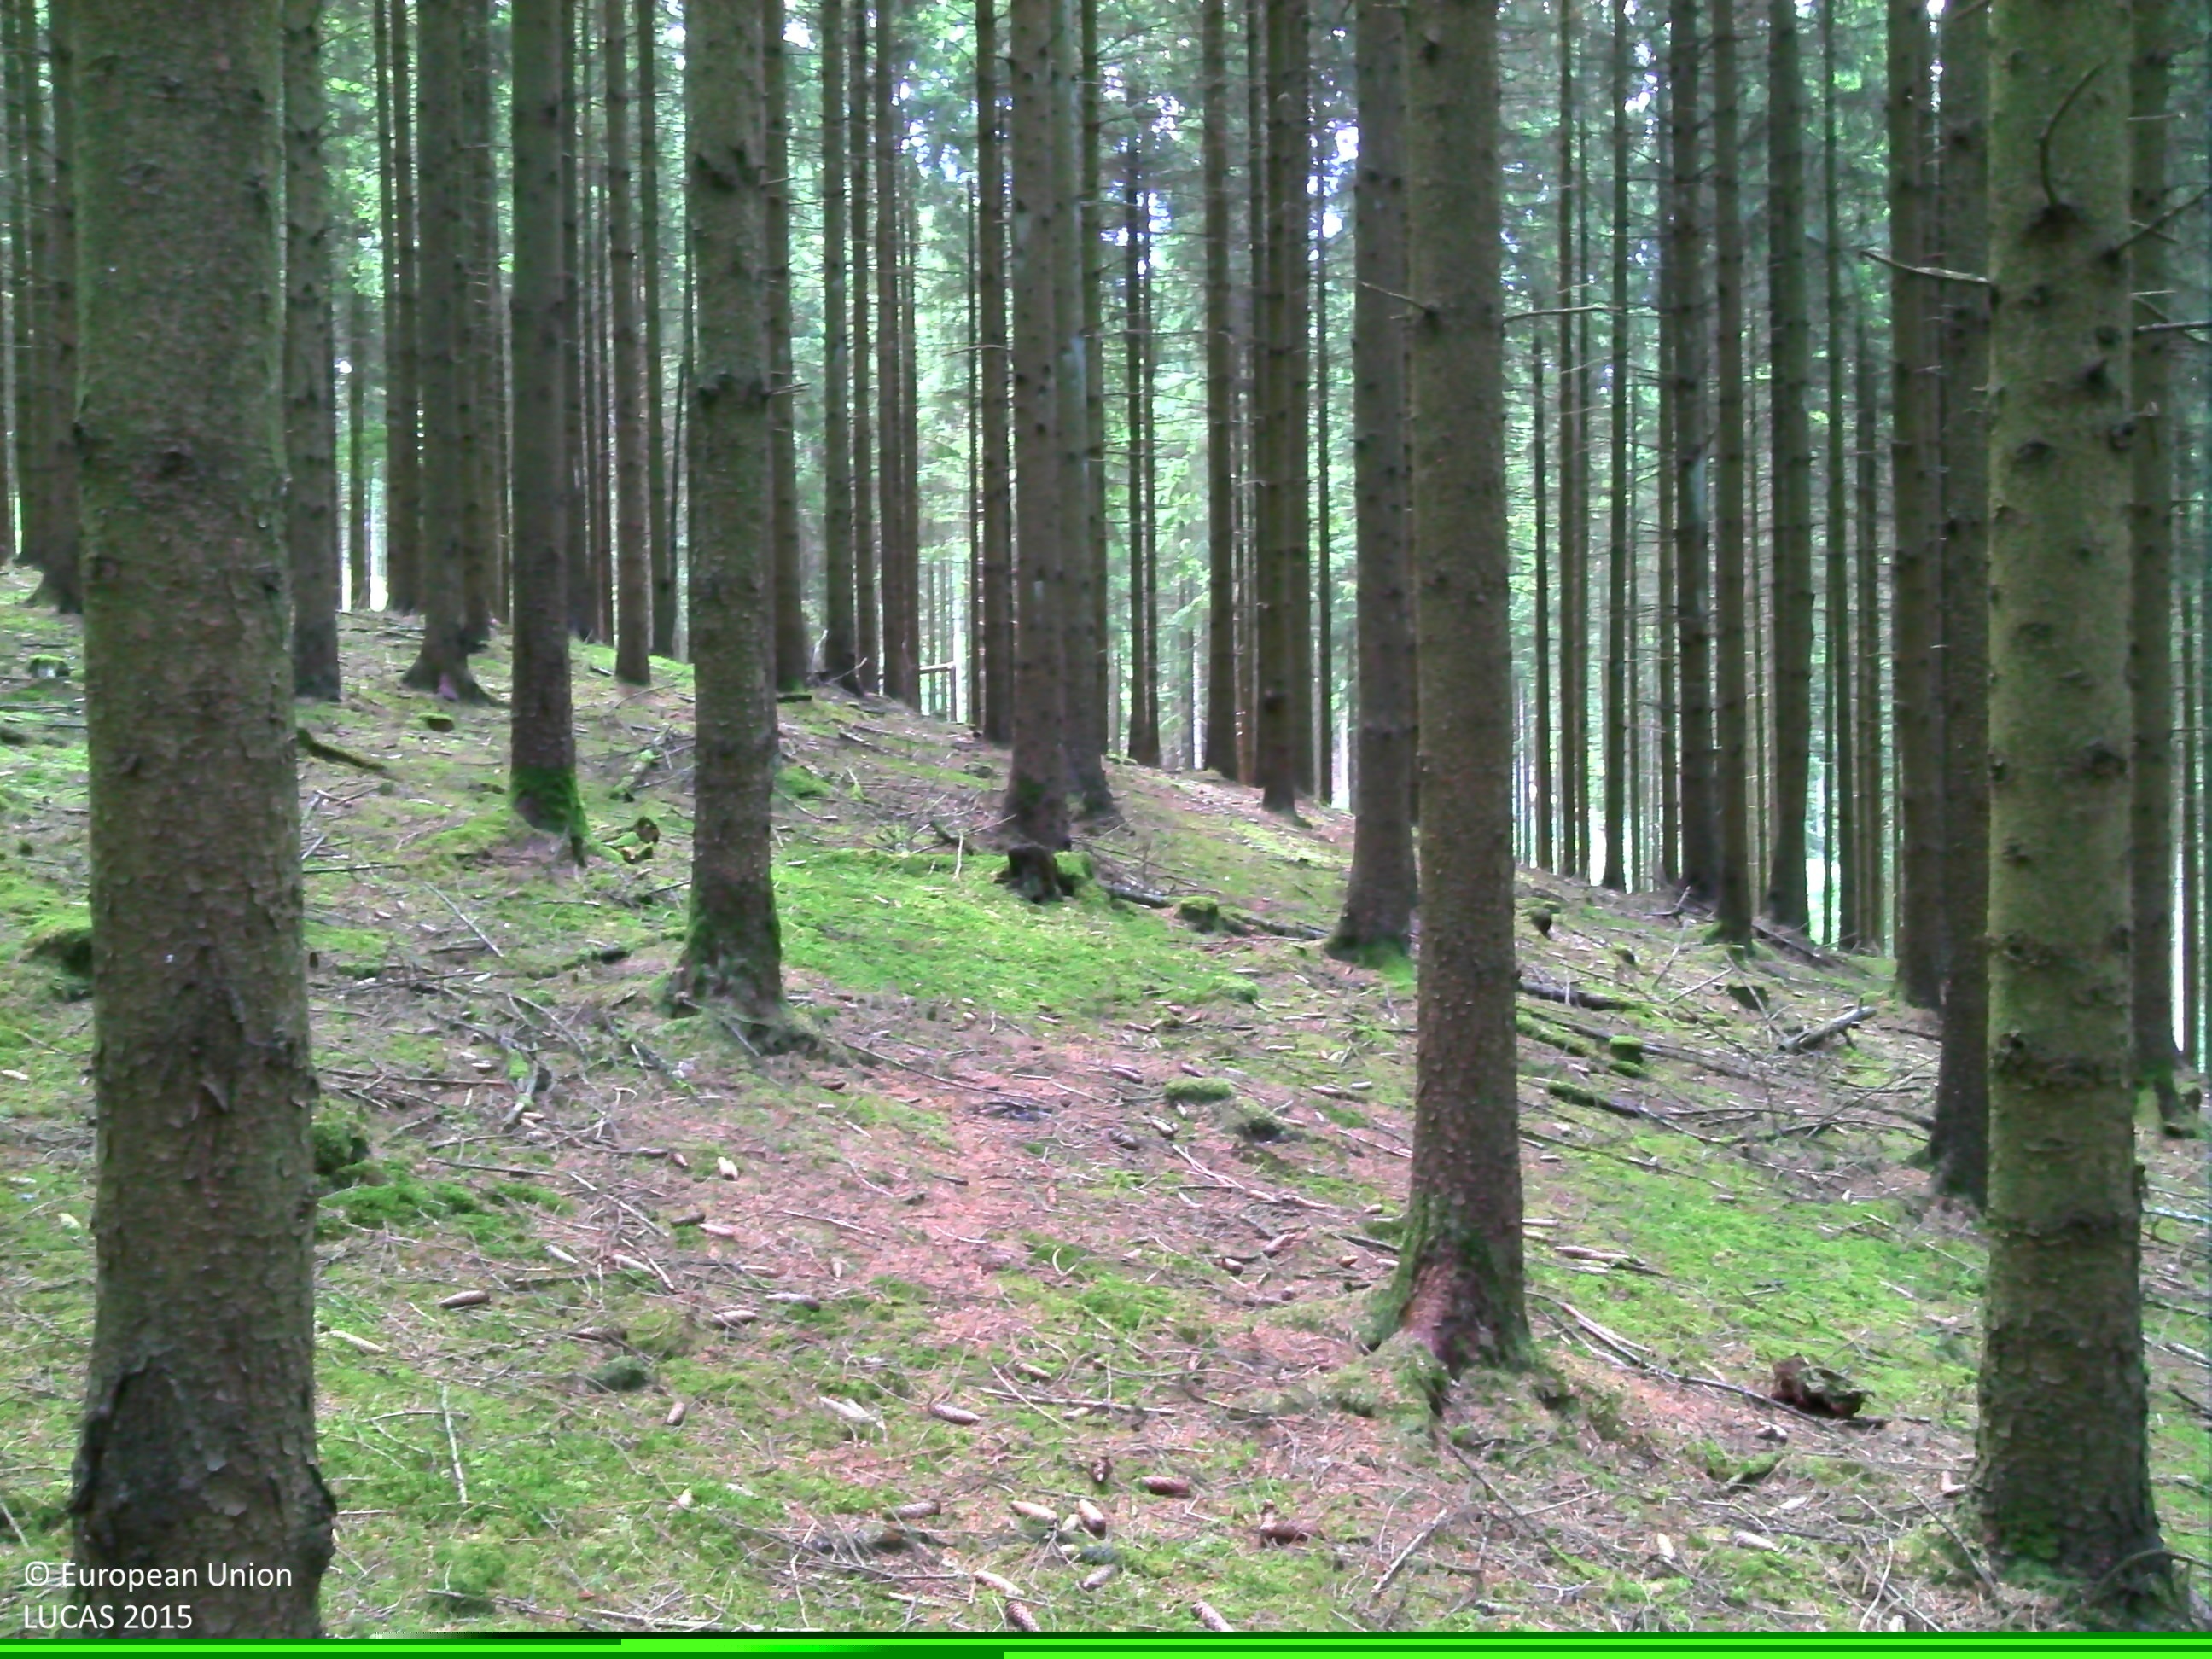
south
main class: Woodland
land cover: Spruce dominated coniferous woodland
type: exotic forest
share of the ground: > 75 %
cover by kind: coniferous forest trees 90 %, lichens and mosses 10 %
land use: Forestry
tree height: > 5 m
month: July
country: BE
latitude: 50.2856
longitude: 6.2802
